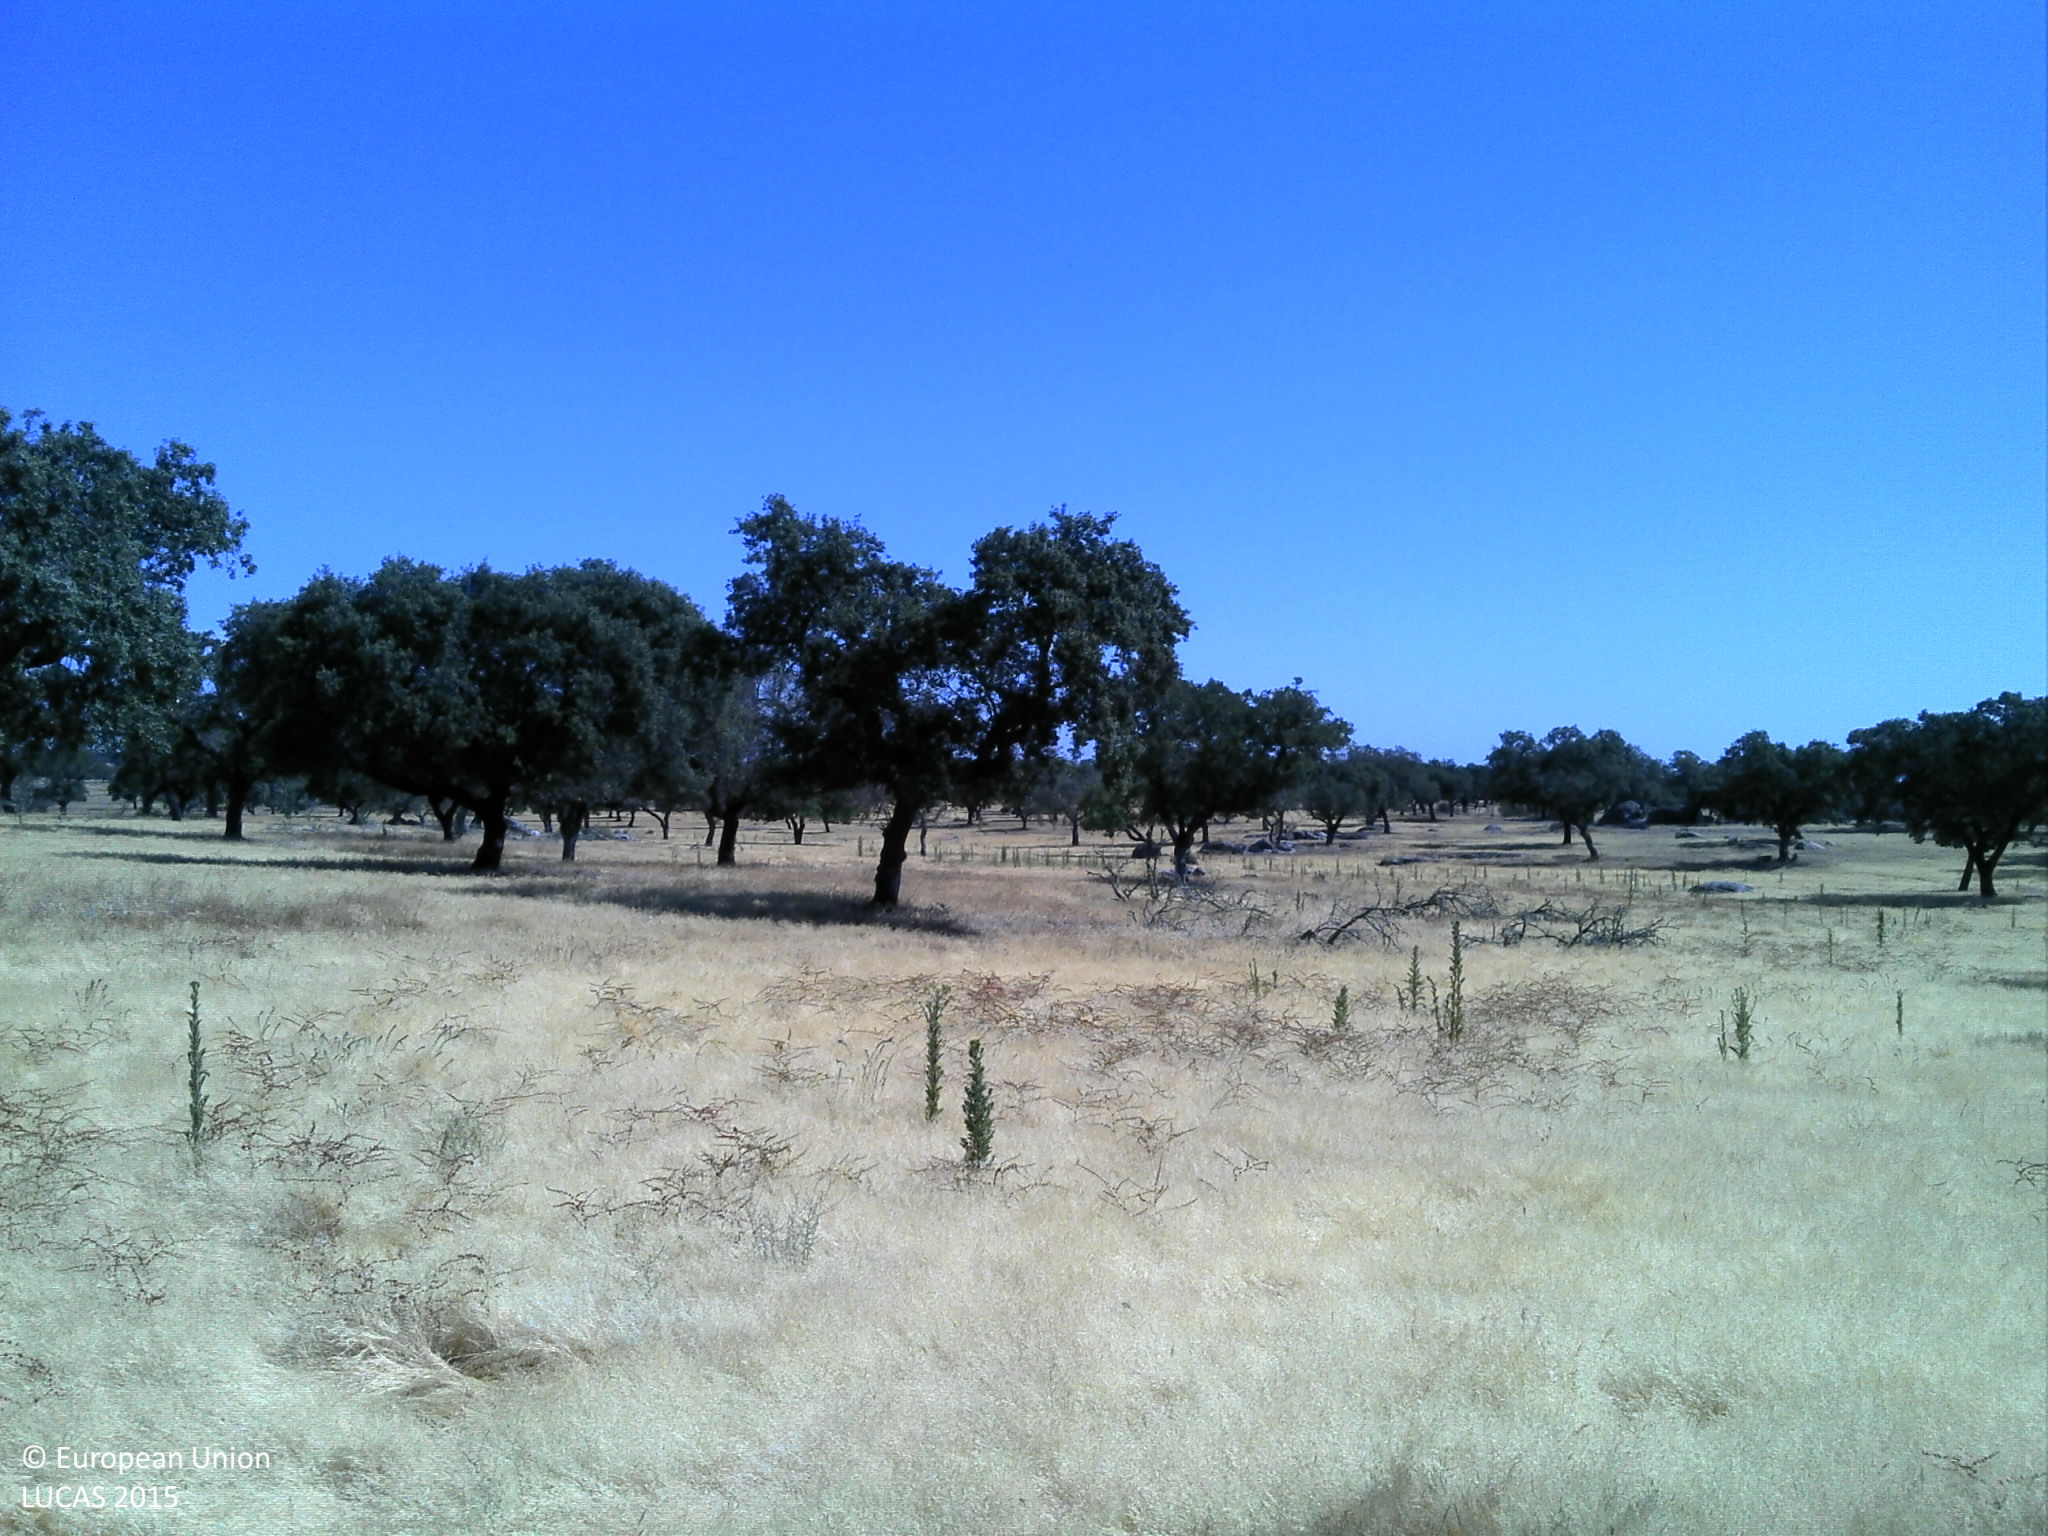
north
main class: Woodland
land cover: Broadleaved woodland
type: broadleaved evergreen forest
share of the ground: 10 - 25 %
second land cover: Grassland without tree/shrub cover
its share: 50 - 75 %
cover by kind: herbaceous plants 60 %, broadleaved forest trees 30 %, consolidated bare surface 10 %
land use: Forestry
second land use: Agriculture (excluding fallow land and kitchen gardens)
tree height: > 5 m
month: June
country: PT
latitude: 38.8610
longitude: -7.9193
